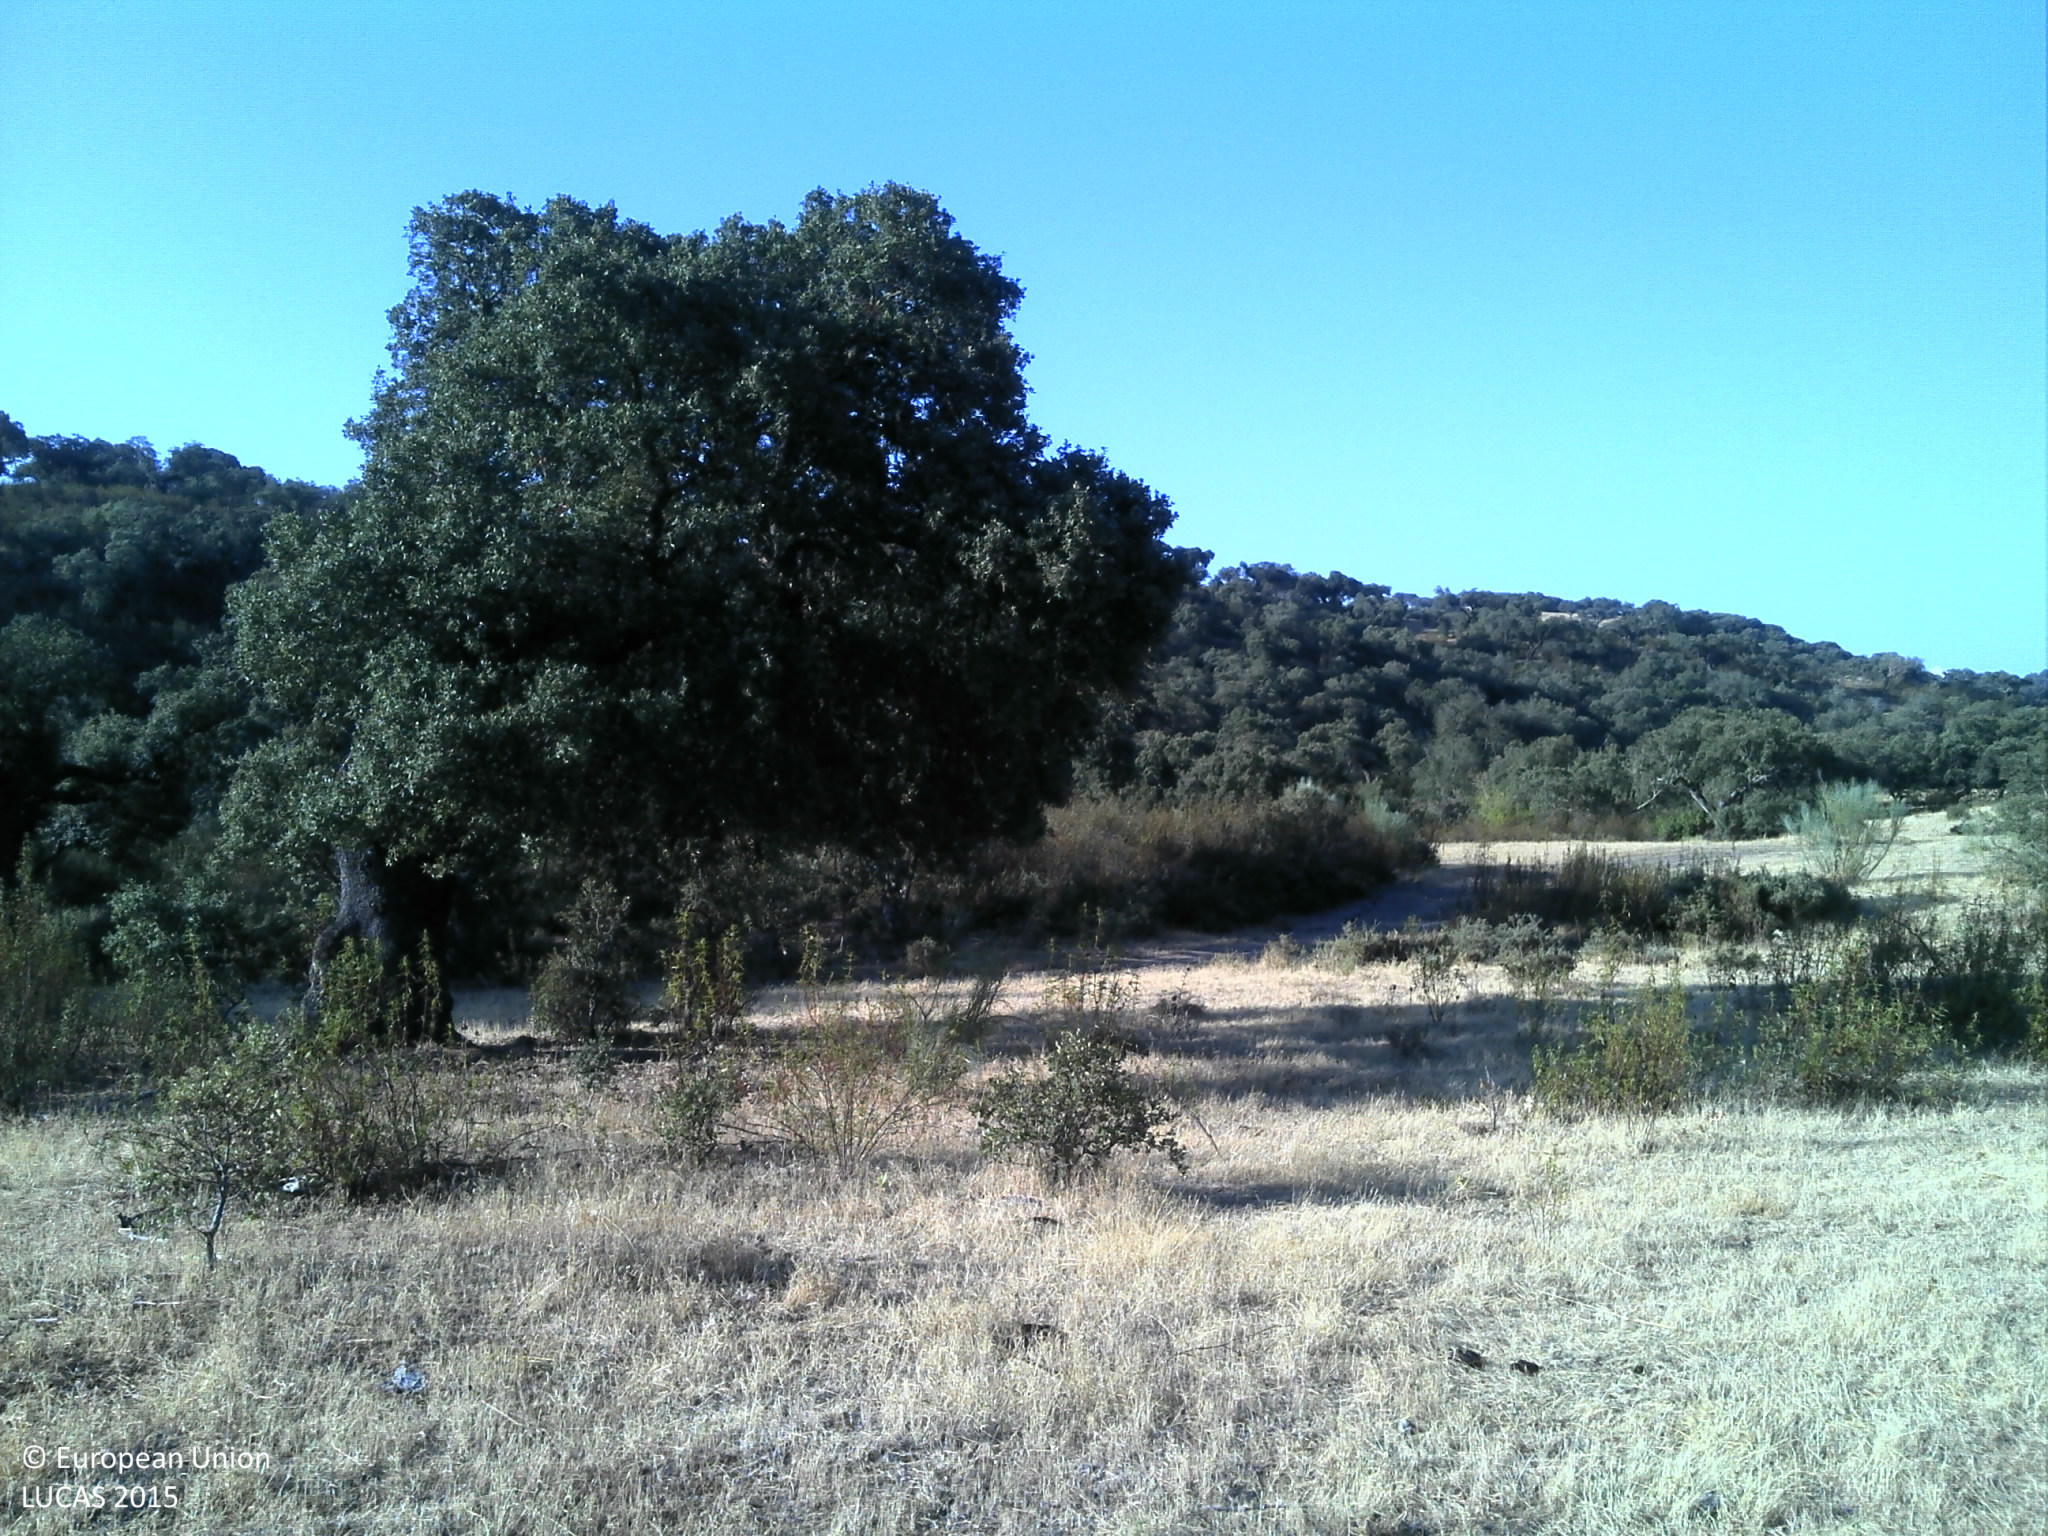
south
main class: Grassland
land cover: Grassland with sparse tree/shrub cover
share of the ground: 10 - 25 %
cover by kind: unconsolidated bare surface 65 %, herbaceous plants 25 %, broadleaved forest trees 5 %, shrubs 5 %
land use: Agriculture (excluding fallow land and kitchen gardens)
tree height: > 5 m
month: July
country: PT
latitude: 38.5762
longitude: -7.4650
